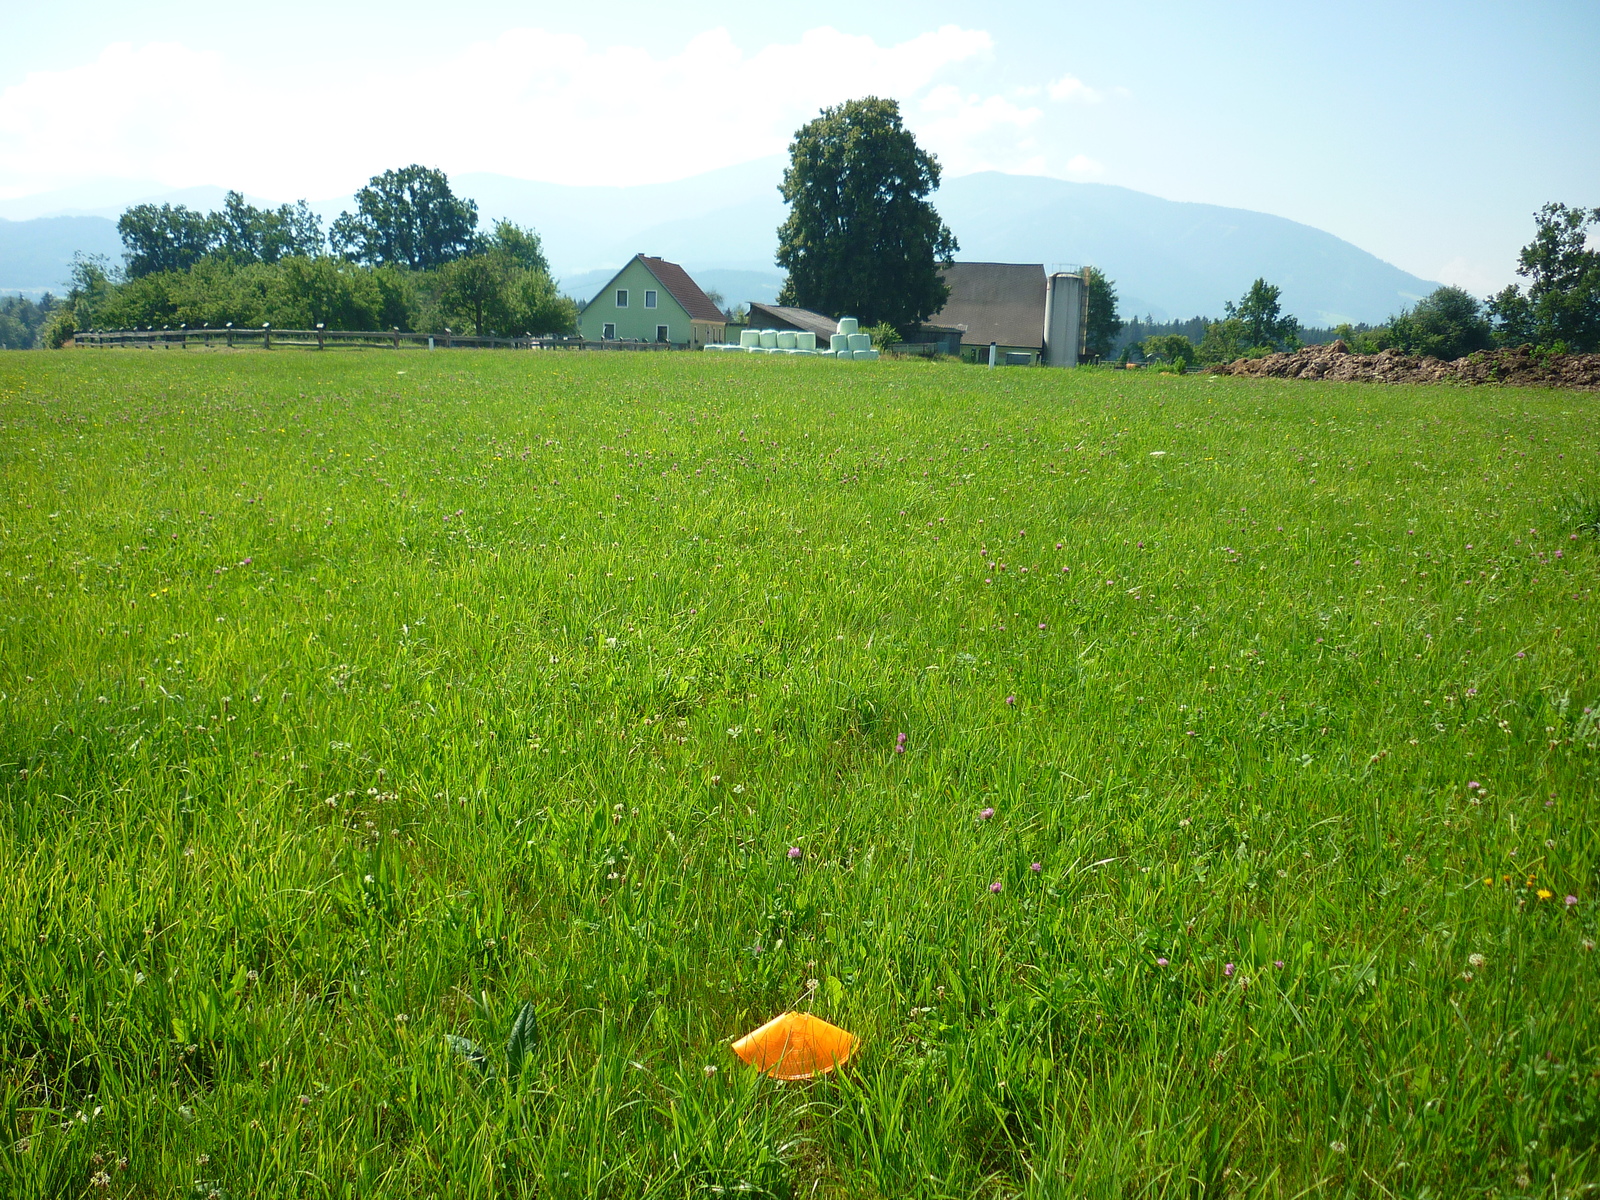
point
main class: Grassland
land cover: Grassland without tree/shrub cover
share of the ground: > 75 %
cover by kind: herbaceous plants 100 %
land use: Agriculture (excluding fallow land and kitchen gardens)
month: July
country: AT
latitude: 47.1843
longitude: 14.7365
